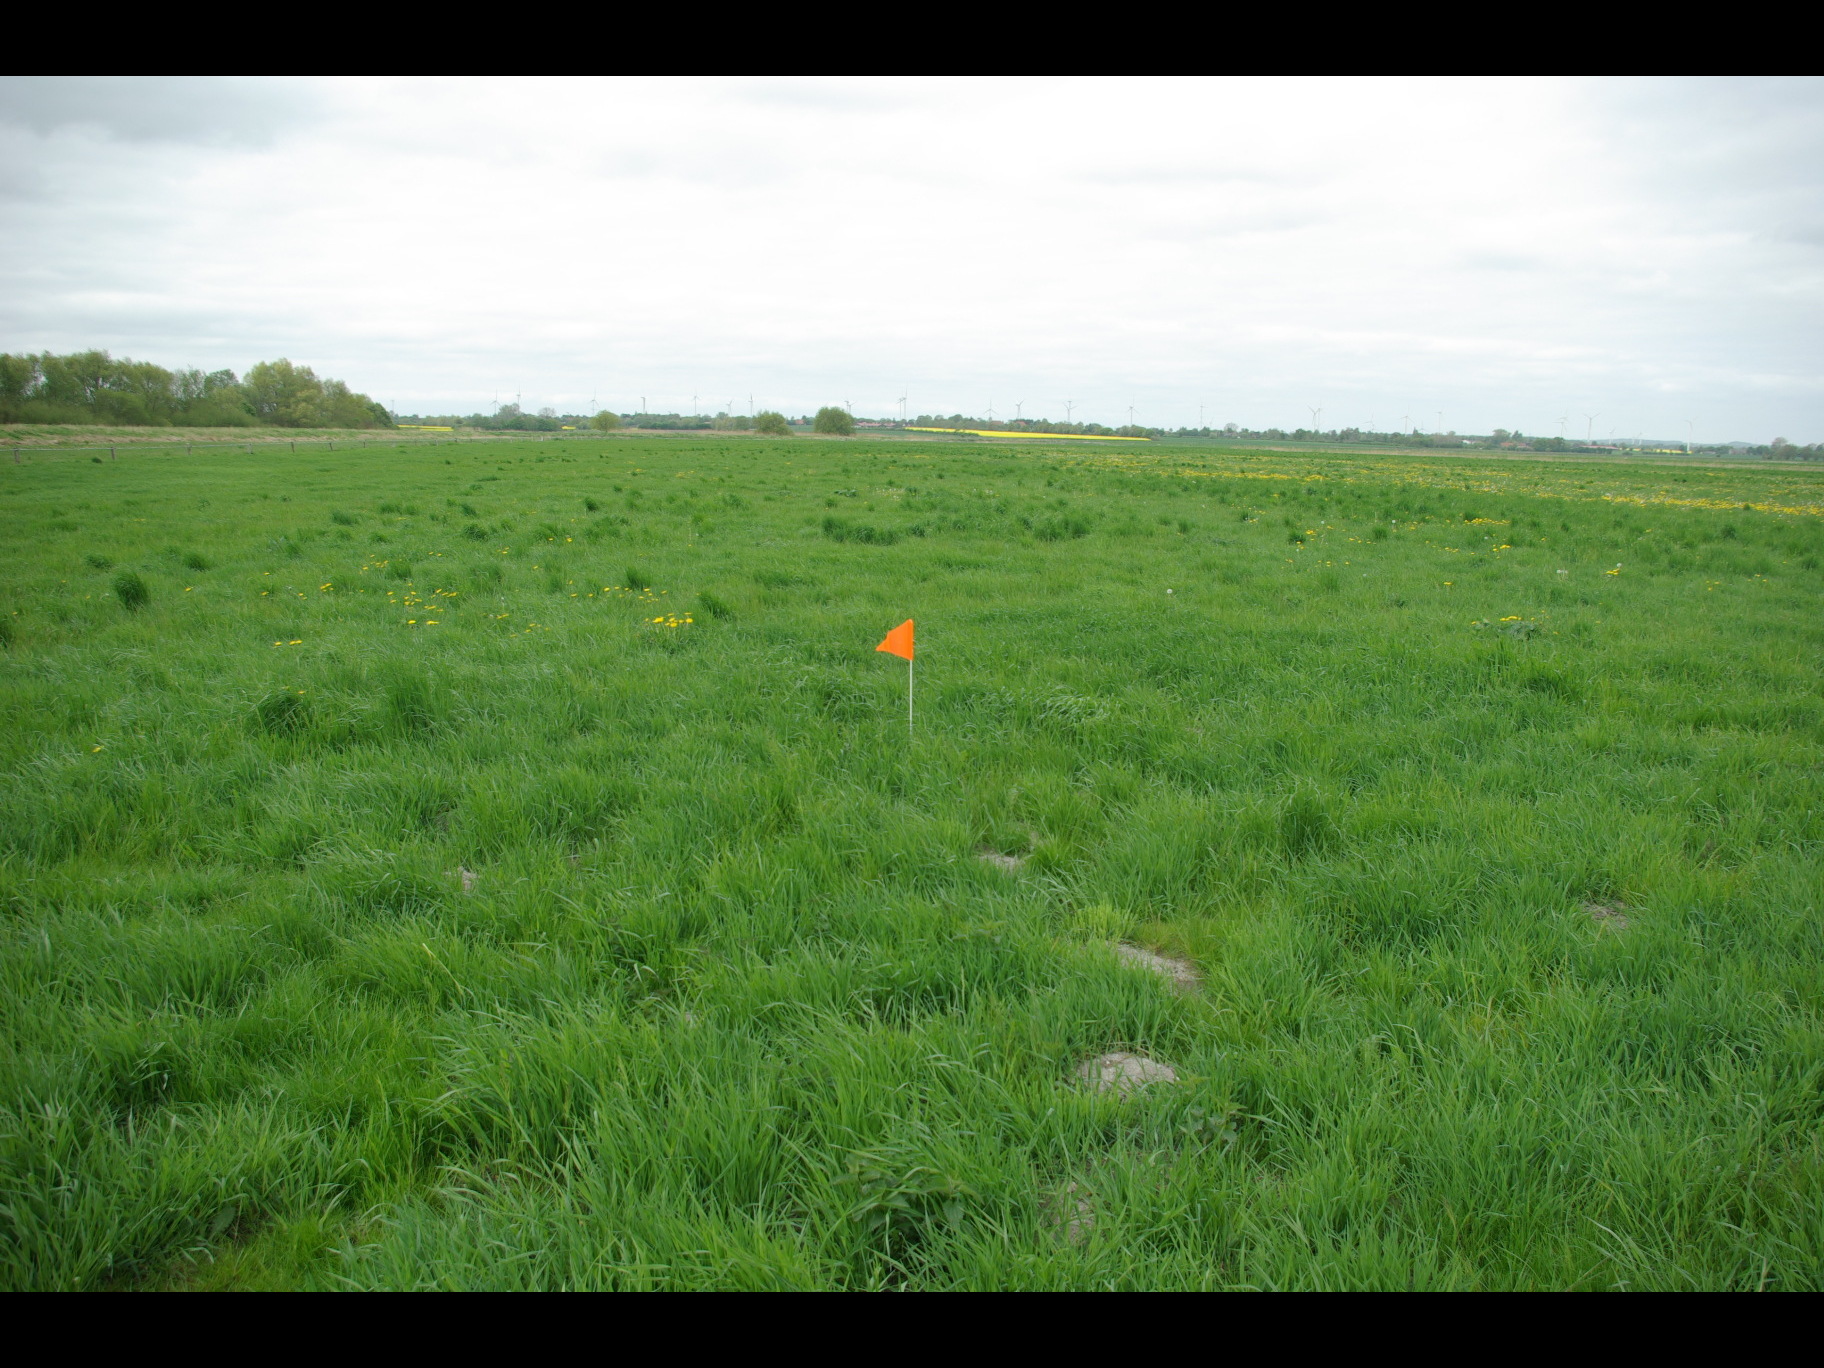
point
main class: Grassland
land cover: Grassland without tree/shrub cover
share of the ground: > 75 %
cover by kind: herbaceous plants 95 %, unconsolidated bare surface 5 %
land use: Agriculture (excluding fallow land and kitchen gardens)
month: May
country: DE
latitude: 54.2426
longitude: 10.9968
